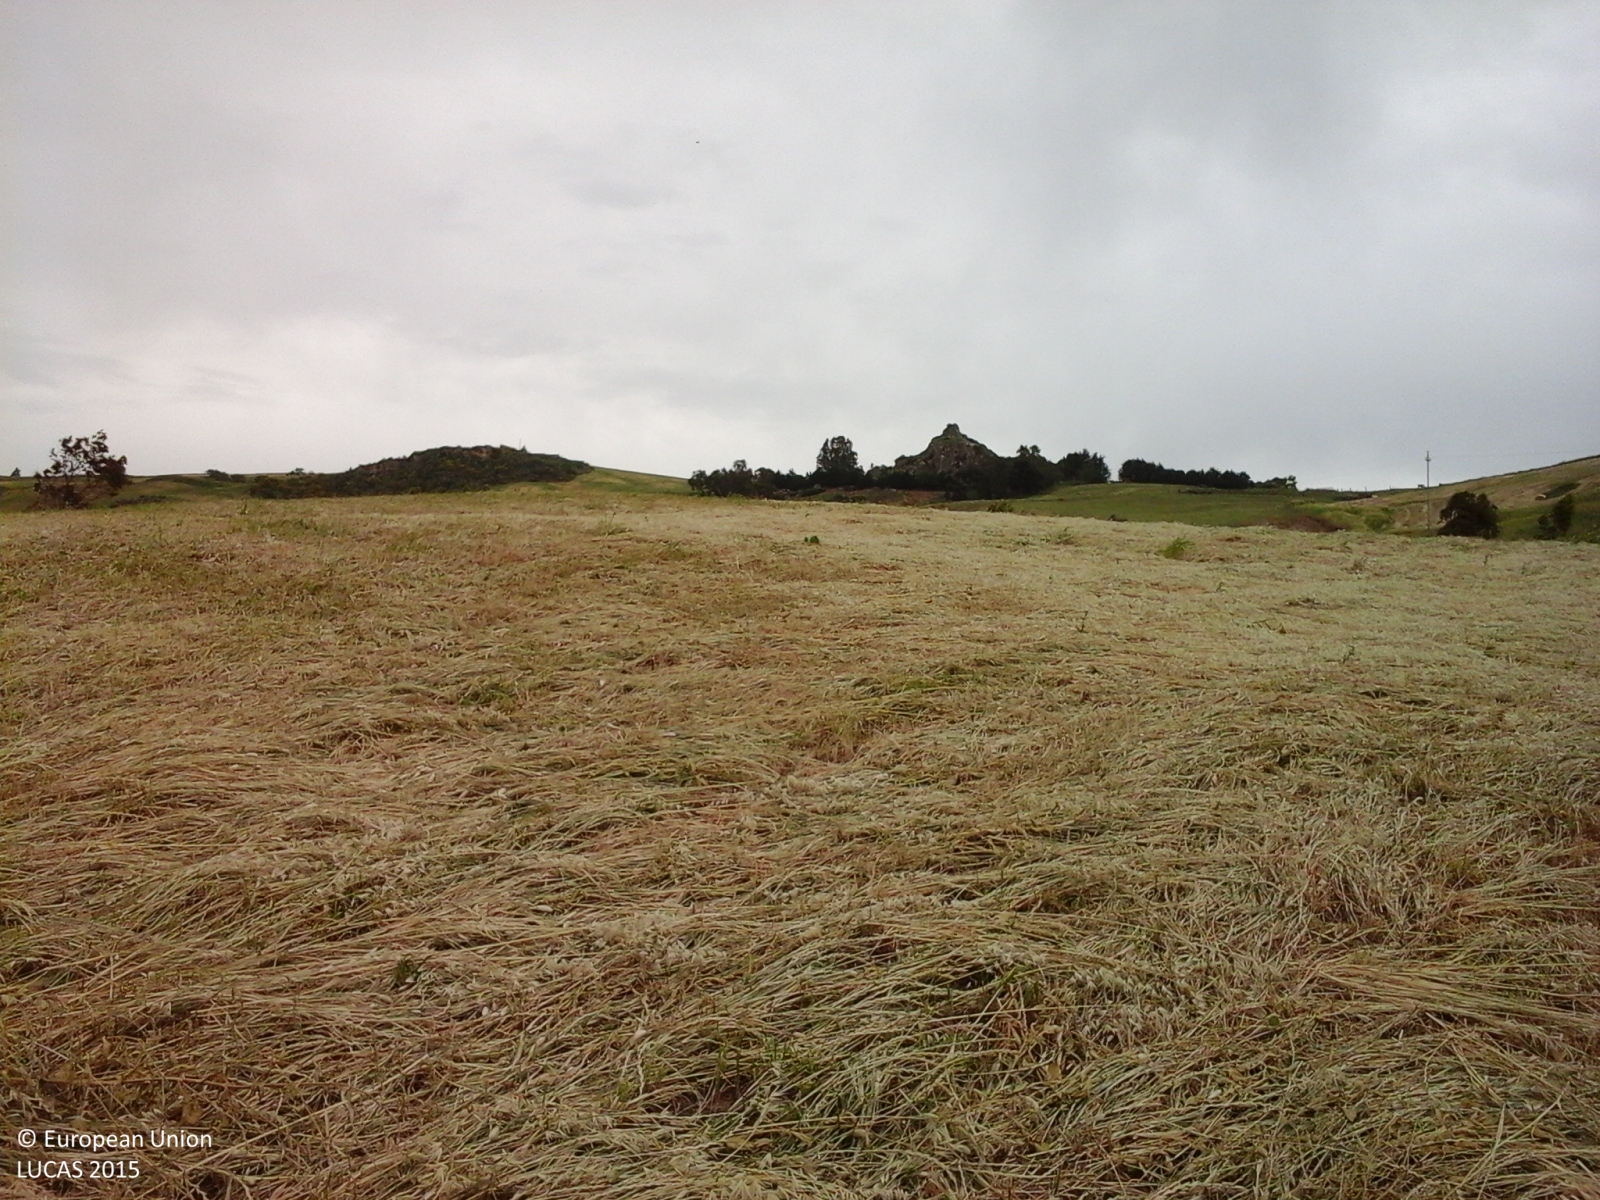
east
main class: Cropland
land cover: Temporary grasslands
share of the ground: > 75 %
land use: Agriculture (excluding fallow land and kitchen gardens)
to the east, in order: Temporary grasslands; Inland fresh running water; Grassland without tree/shrub cover; Temporary grasslands
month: May
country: IT
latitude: 37.6763
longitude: 13.6805
